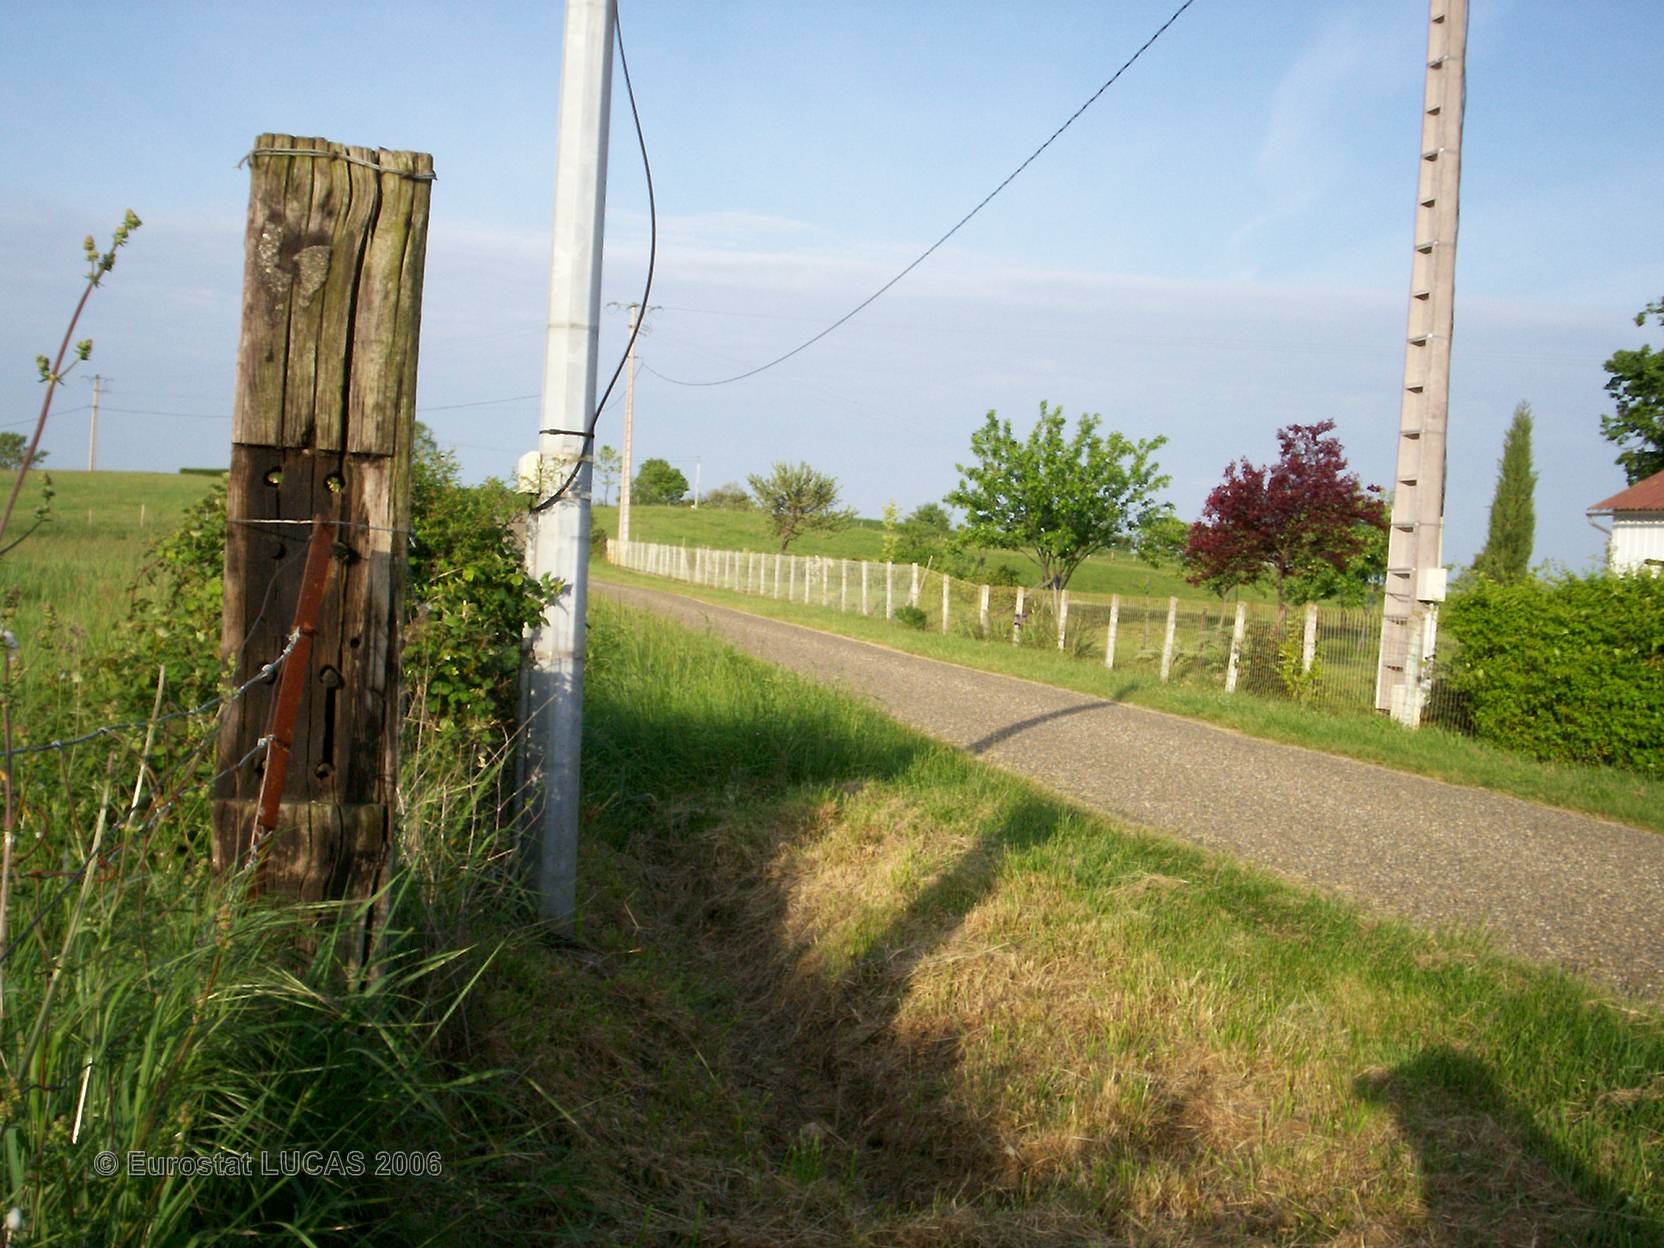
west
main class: Grassland
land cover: Grassland without tree/shrub cover
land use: Agriculture (excluding fallow land and kitchen gardens)
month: May
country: FR
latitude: 43.7401
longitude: 0.1977
